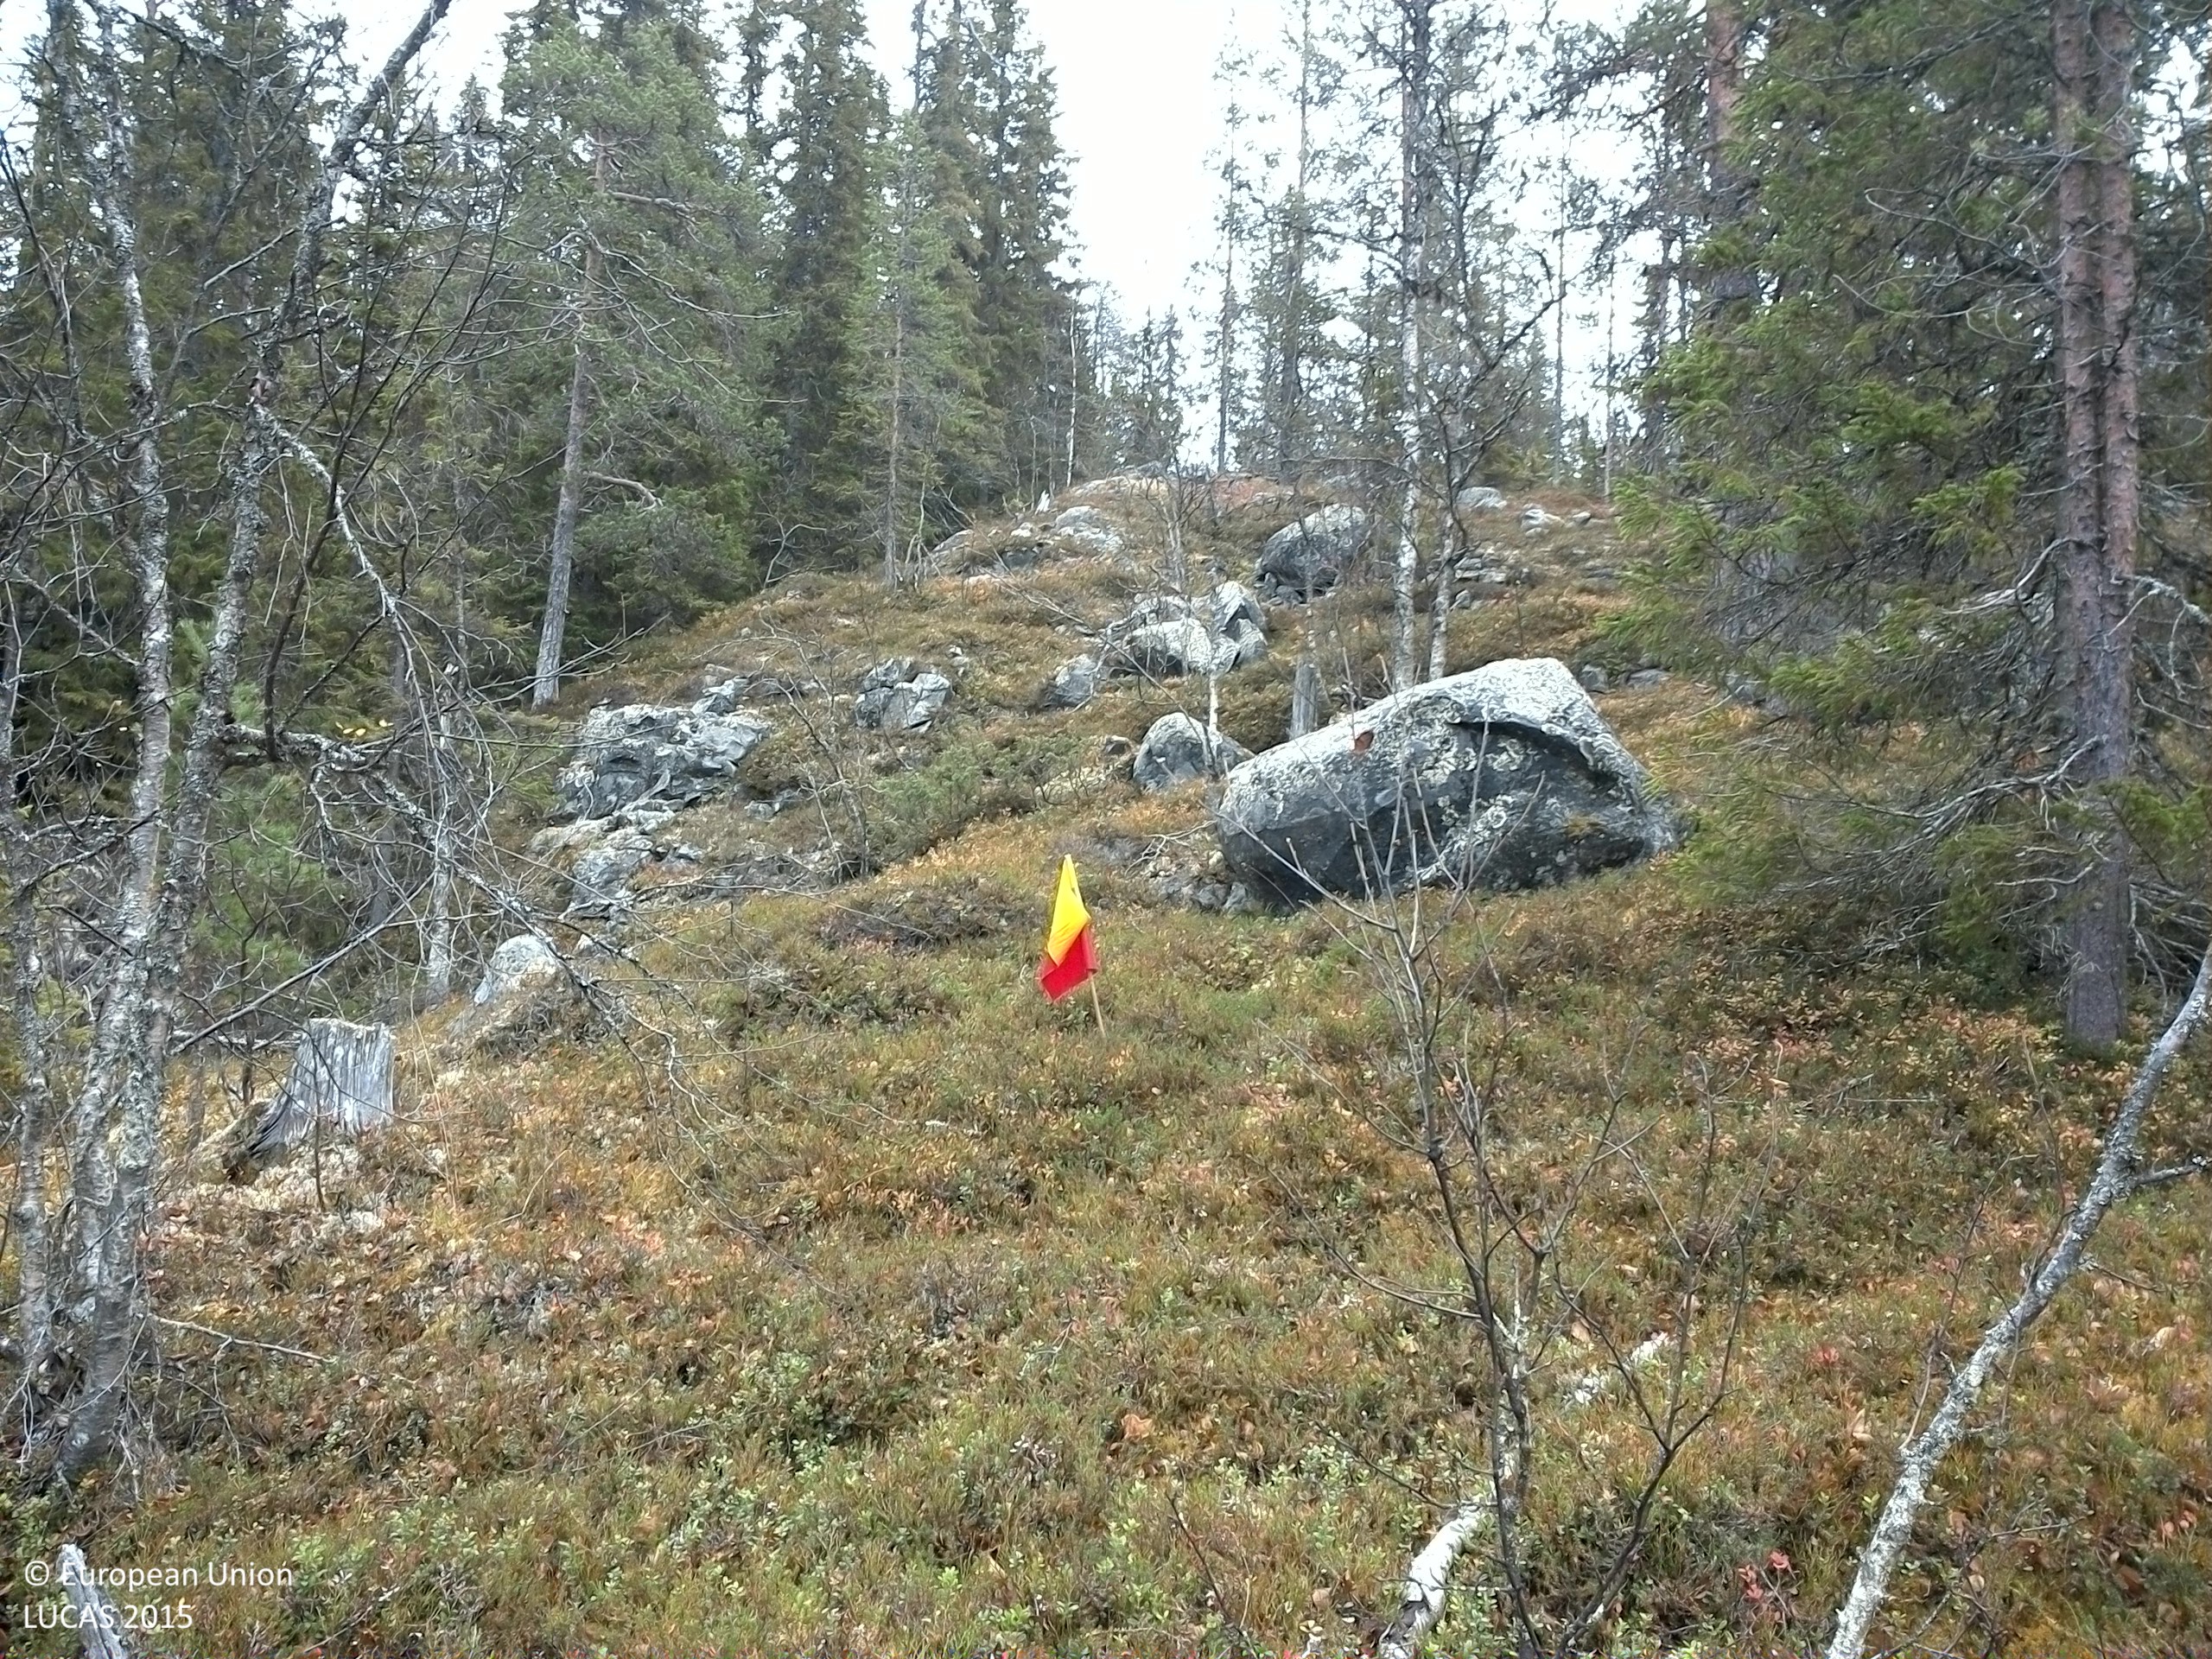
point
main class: Woodland
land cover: Other mixed woodland
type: boreal forest
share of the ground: 25 - 50 %
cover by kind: shrubs 30 %, coniferous forest trees 25 %, consolidated bare surface 20 %, lichens and mosses 15 %, broadleaved forest trees 10 %
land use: Forestry
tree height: > 5 m
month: October
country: SE
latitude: 64.4194
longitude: 15.2644
